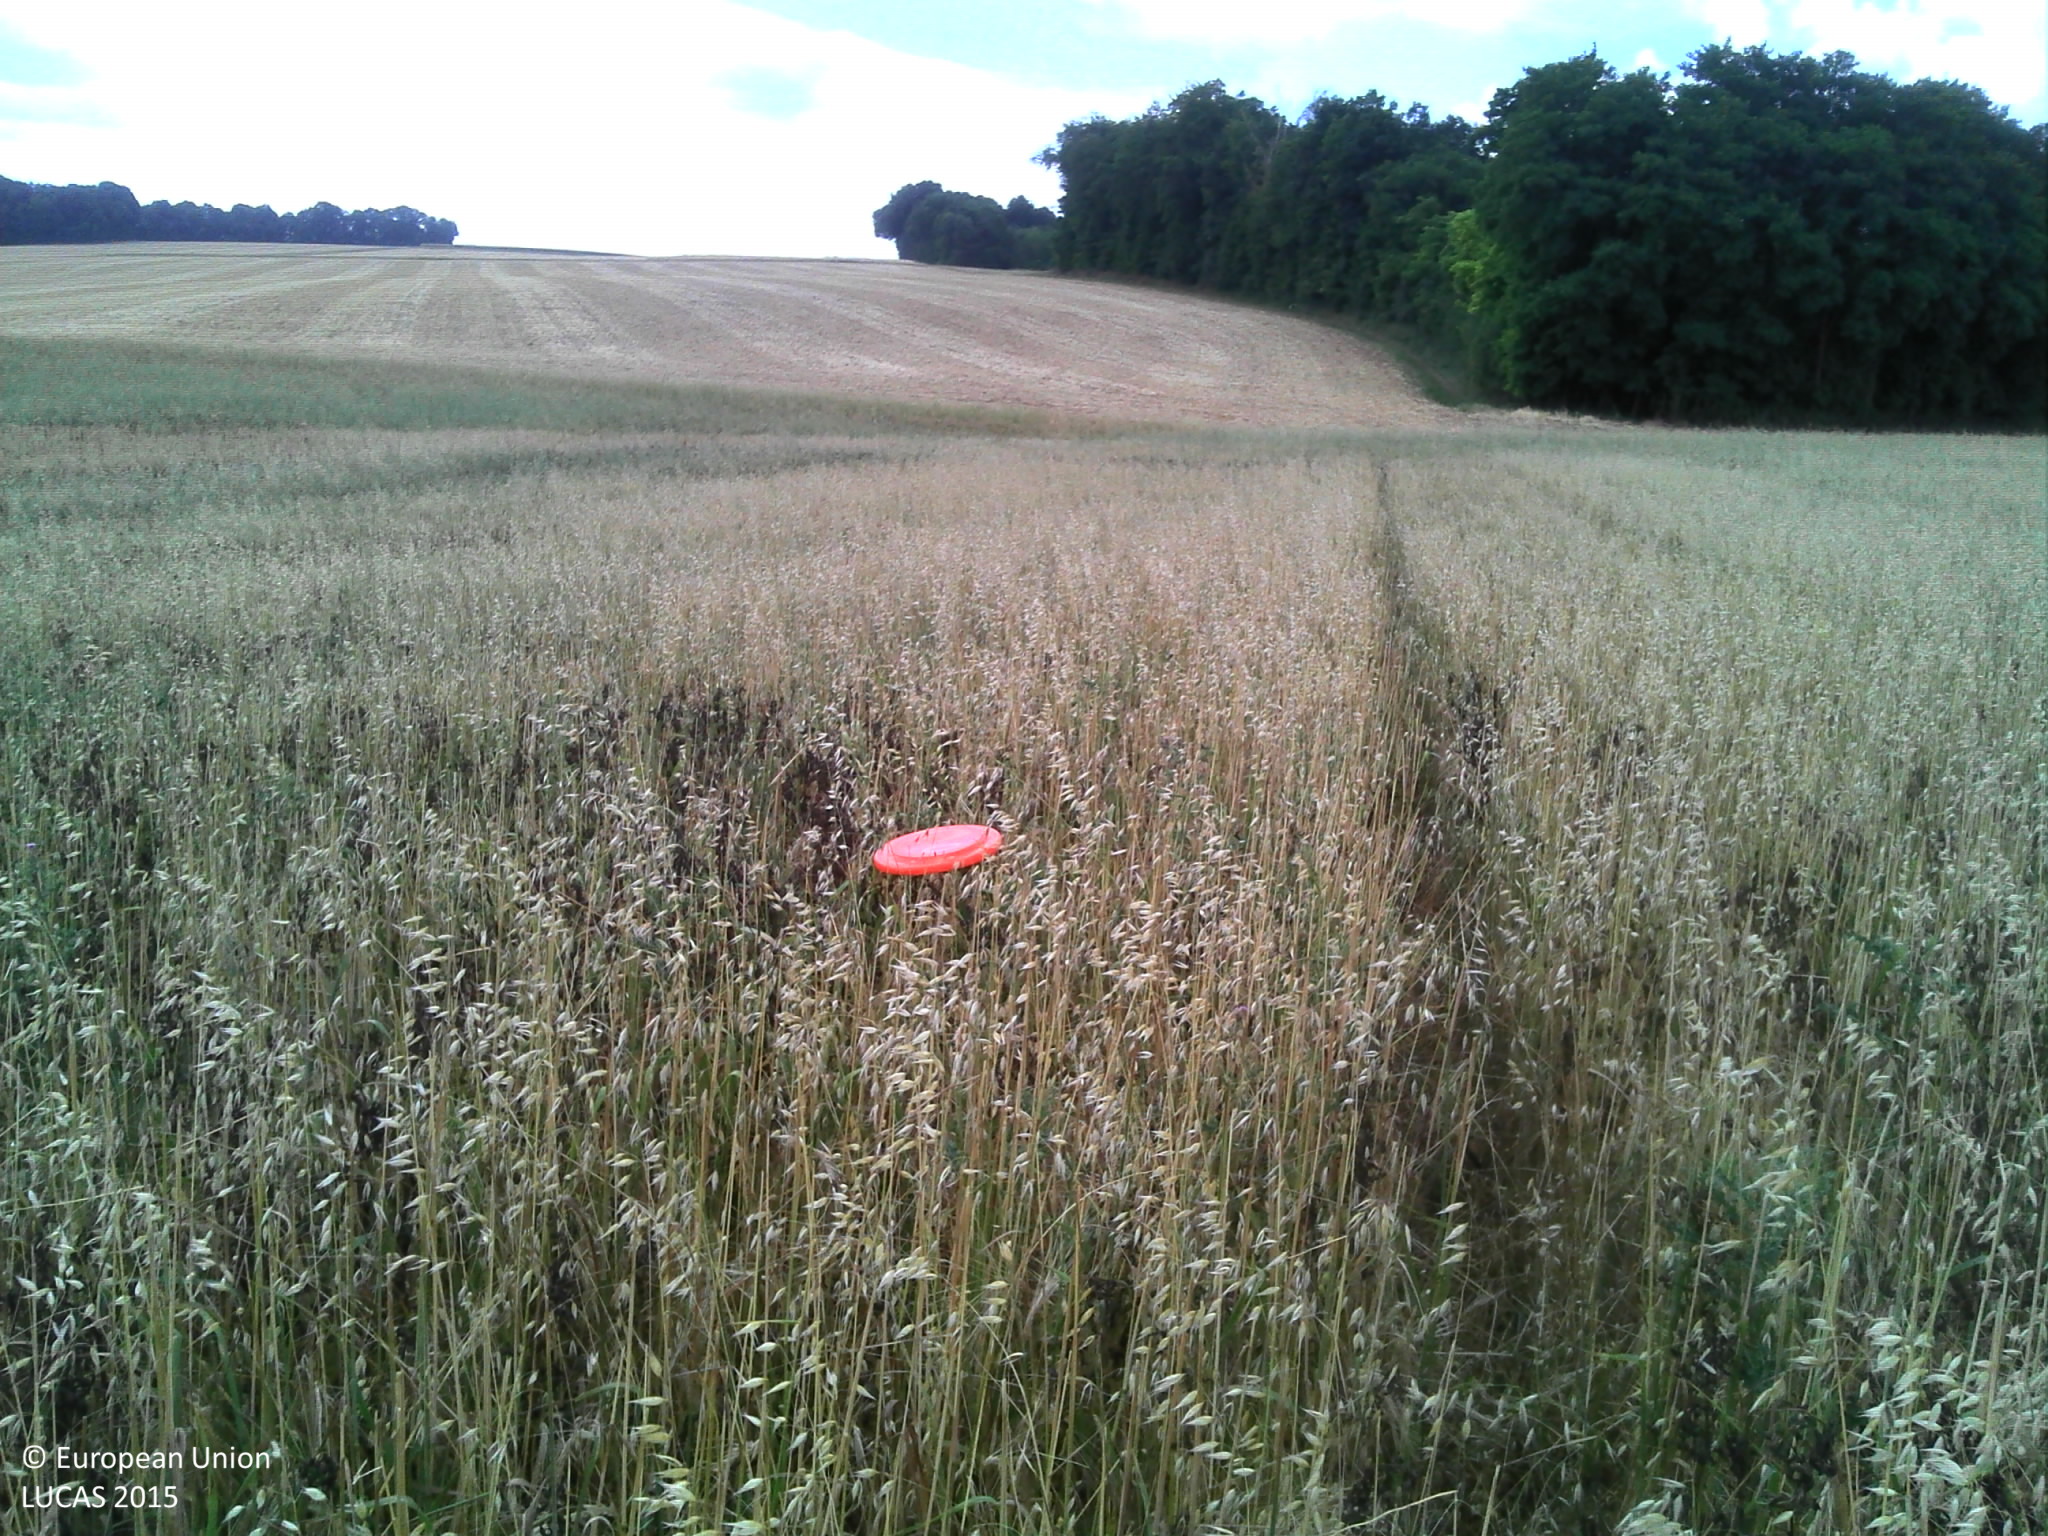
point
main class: Cropland
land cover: Mixed cereals for fodder
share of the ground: > 75 %
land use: Agriculture (excluding fallow land and kitchen gardens)
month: July
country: FR
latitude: 48.3309
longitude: 3.3707
